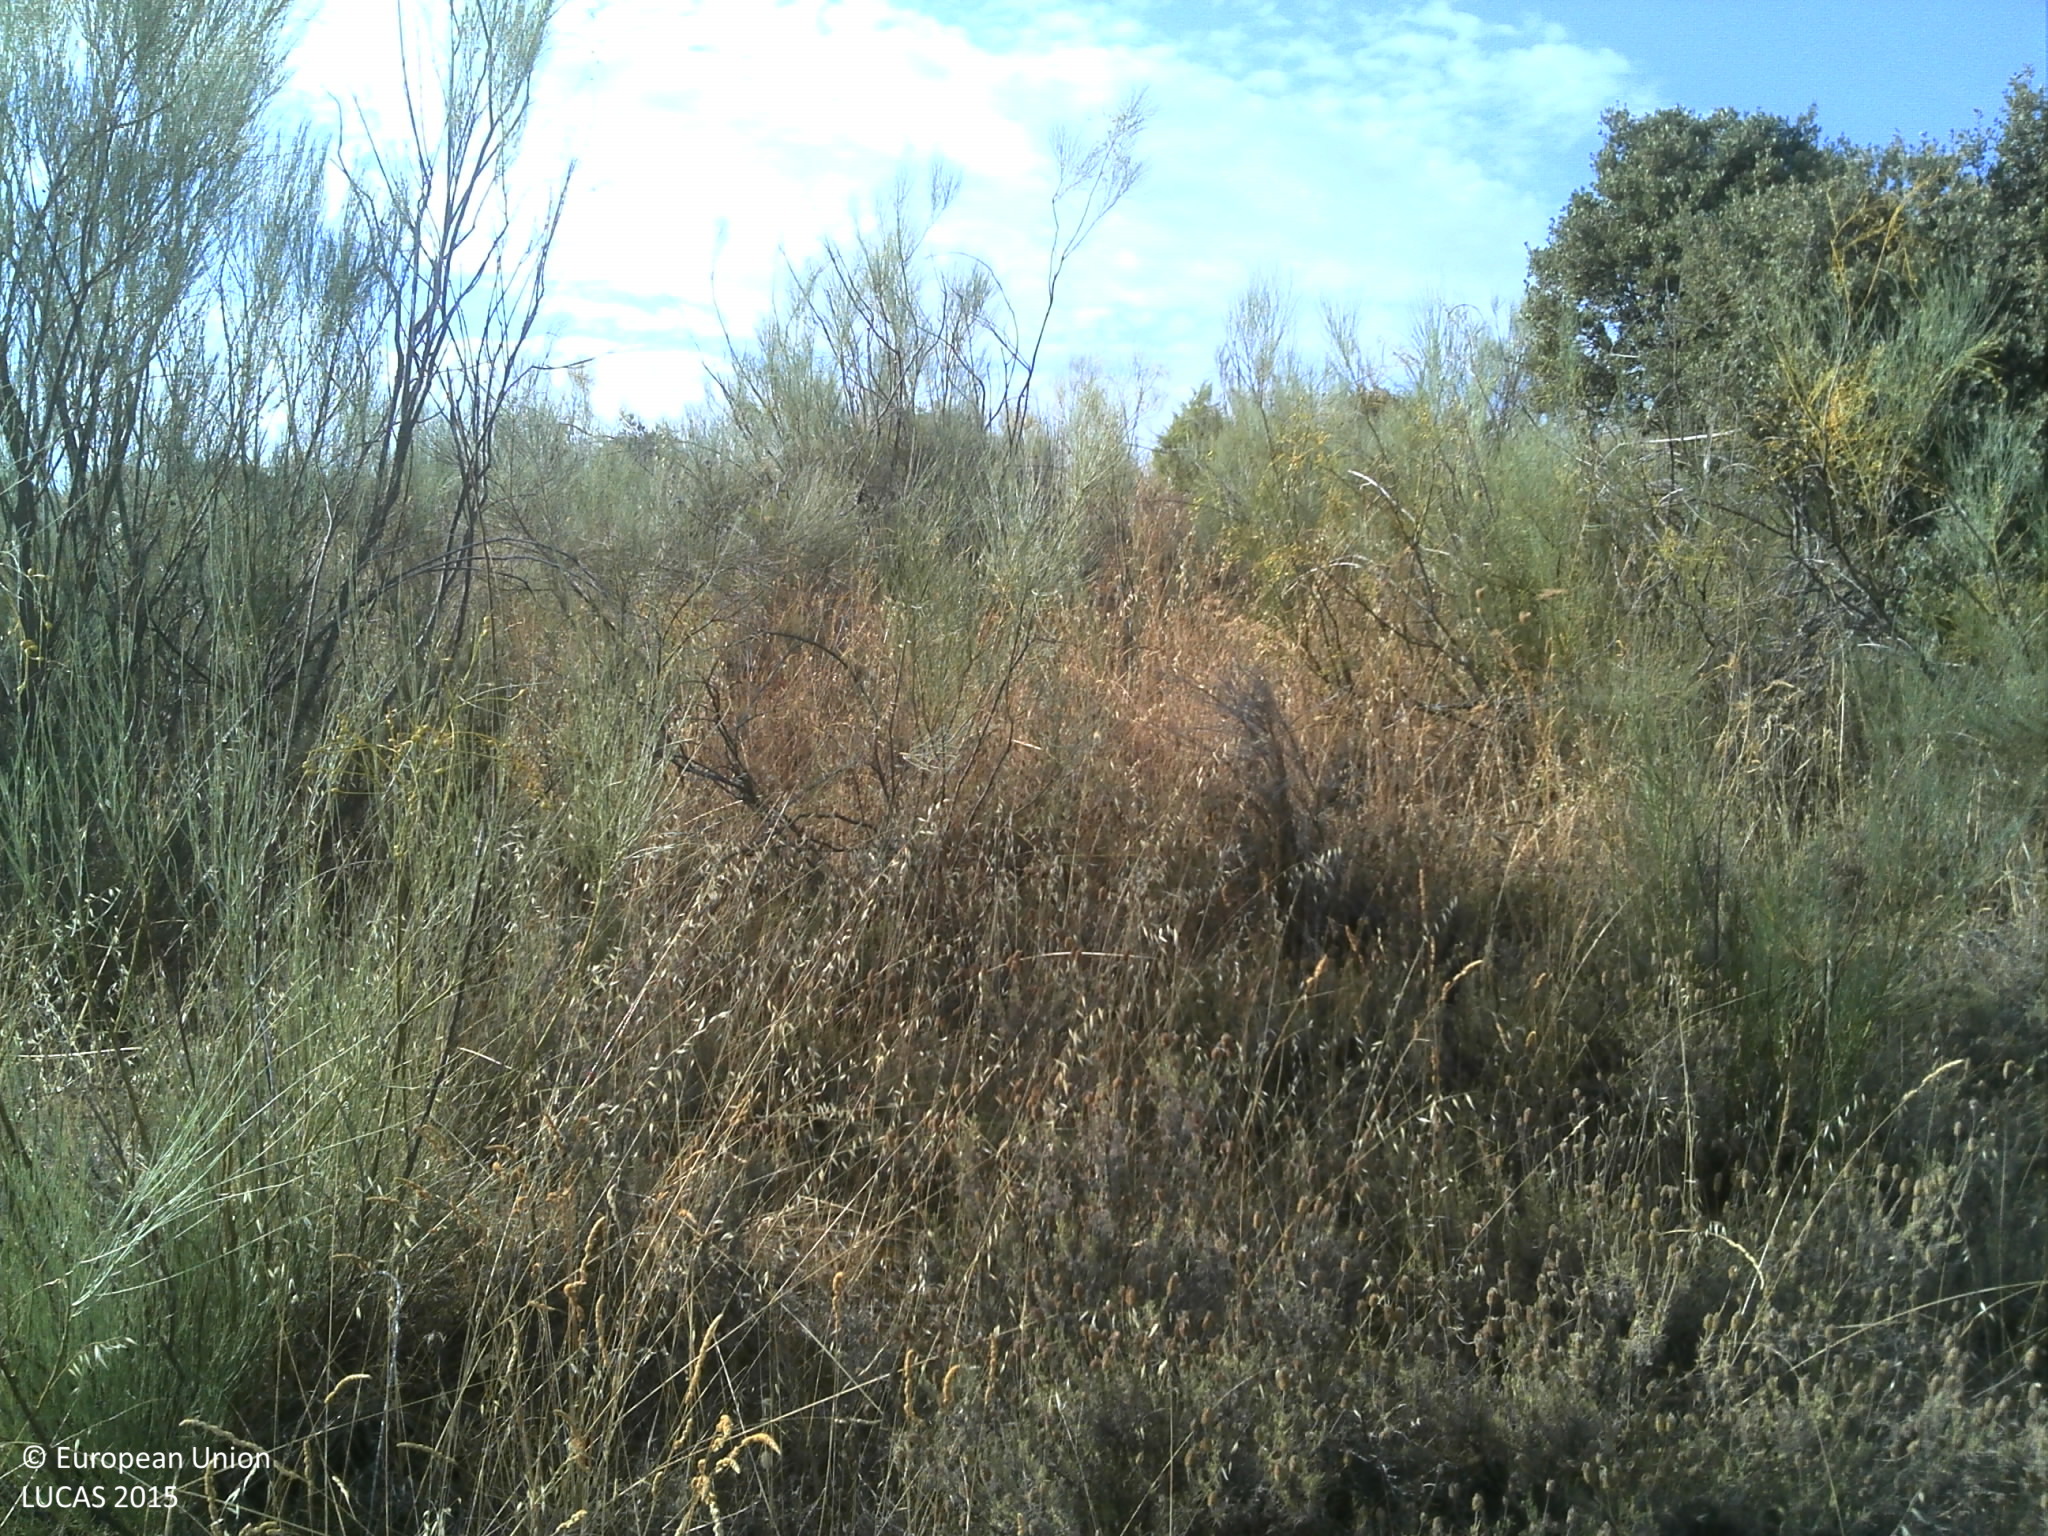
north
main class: Shrubland
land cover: Shrubland with sparse tree cover
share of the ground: > 75 %
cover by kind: shrubs 75 %, herbaceous plants 15 %, broadleaved forest trees 5 %, unconsolidated bare surface 5 %
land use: Abandoned areas
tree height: < 5 m
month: July
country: PT
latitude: 41.0909
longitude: -7.1233
